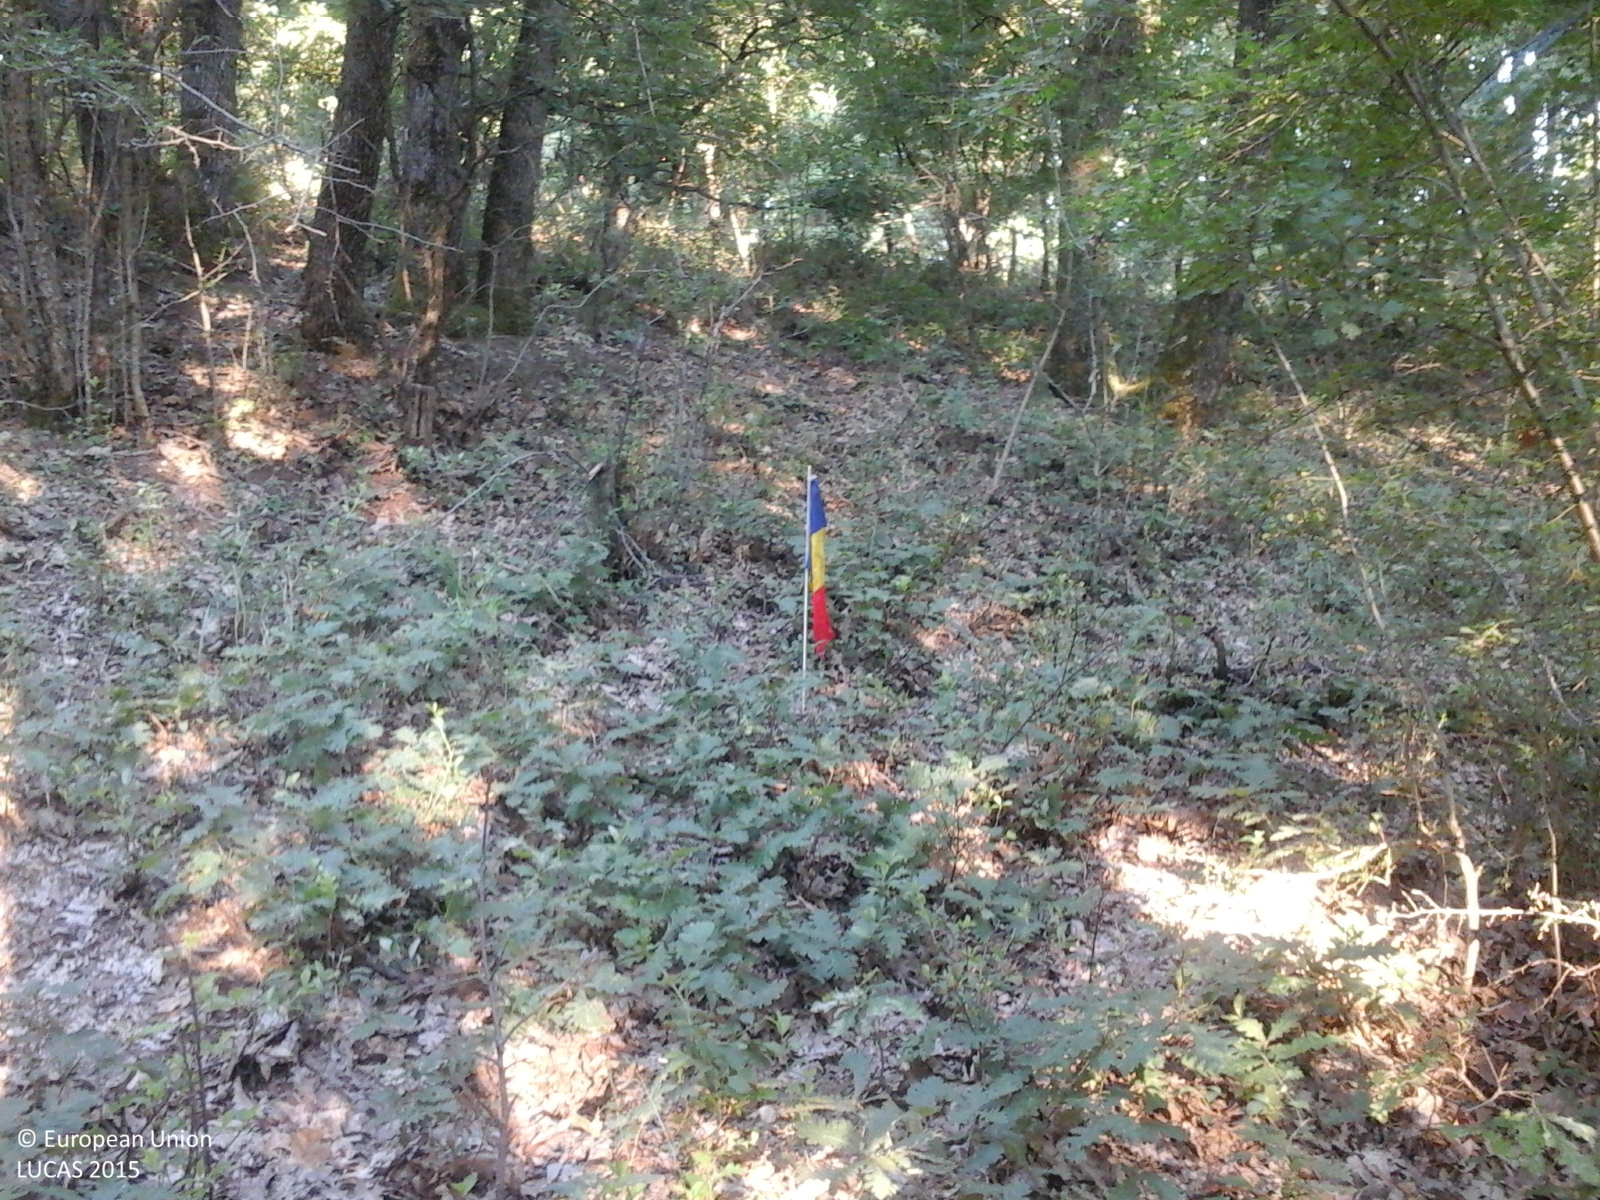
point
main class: Woodland
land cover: Broadleaved woodland
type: acidophilous oak and oak-birch forest
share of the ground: > 75 %
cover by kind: broadleaved forest trees 95 %, herbaceous plants 5 %
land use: Forestry
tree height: > 5 m
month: July
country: RO
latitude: 44.5646
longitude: 24.5393
